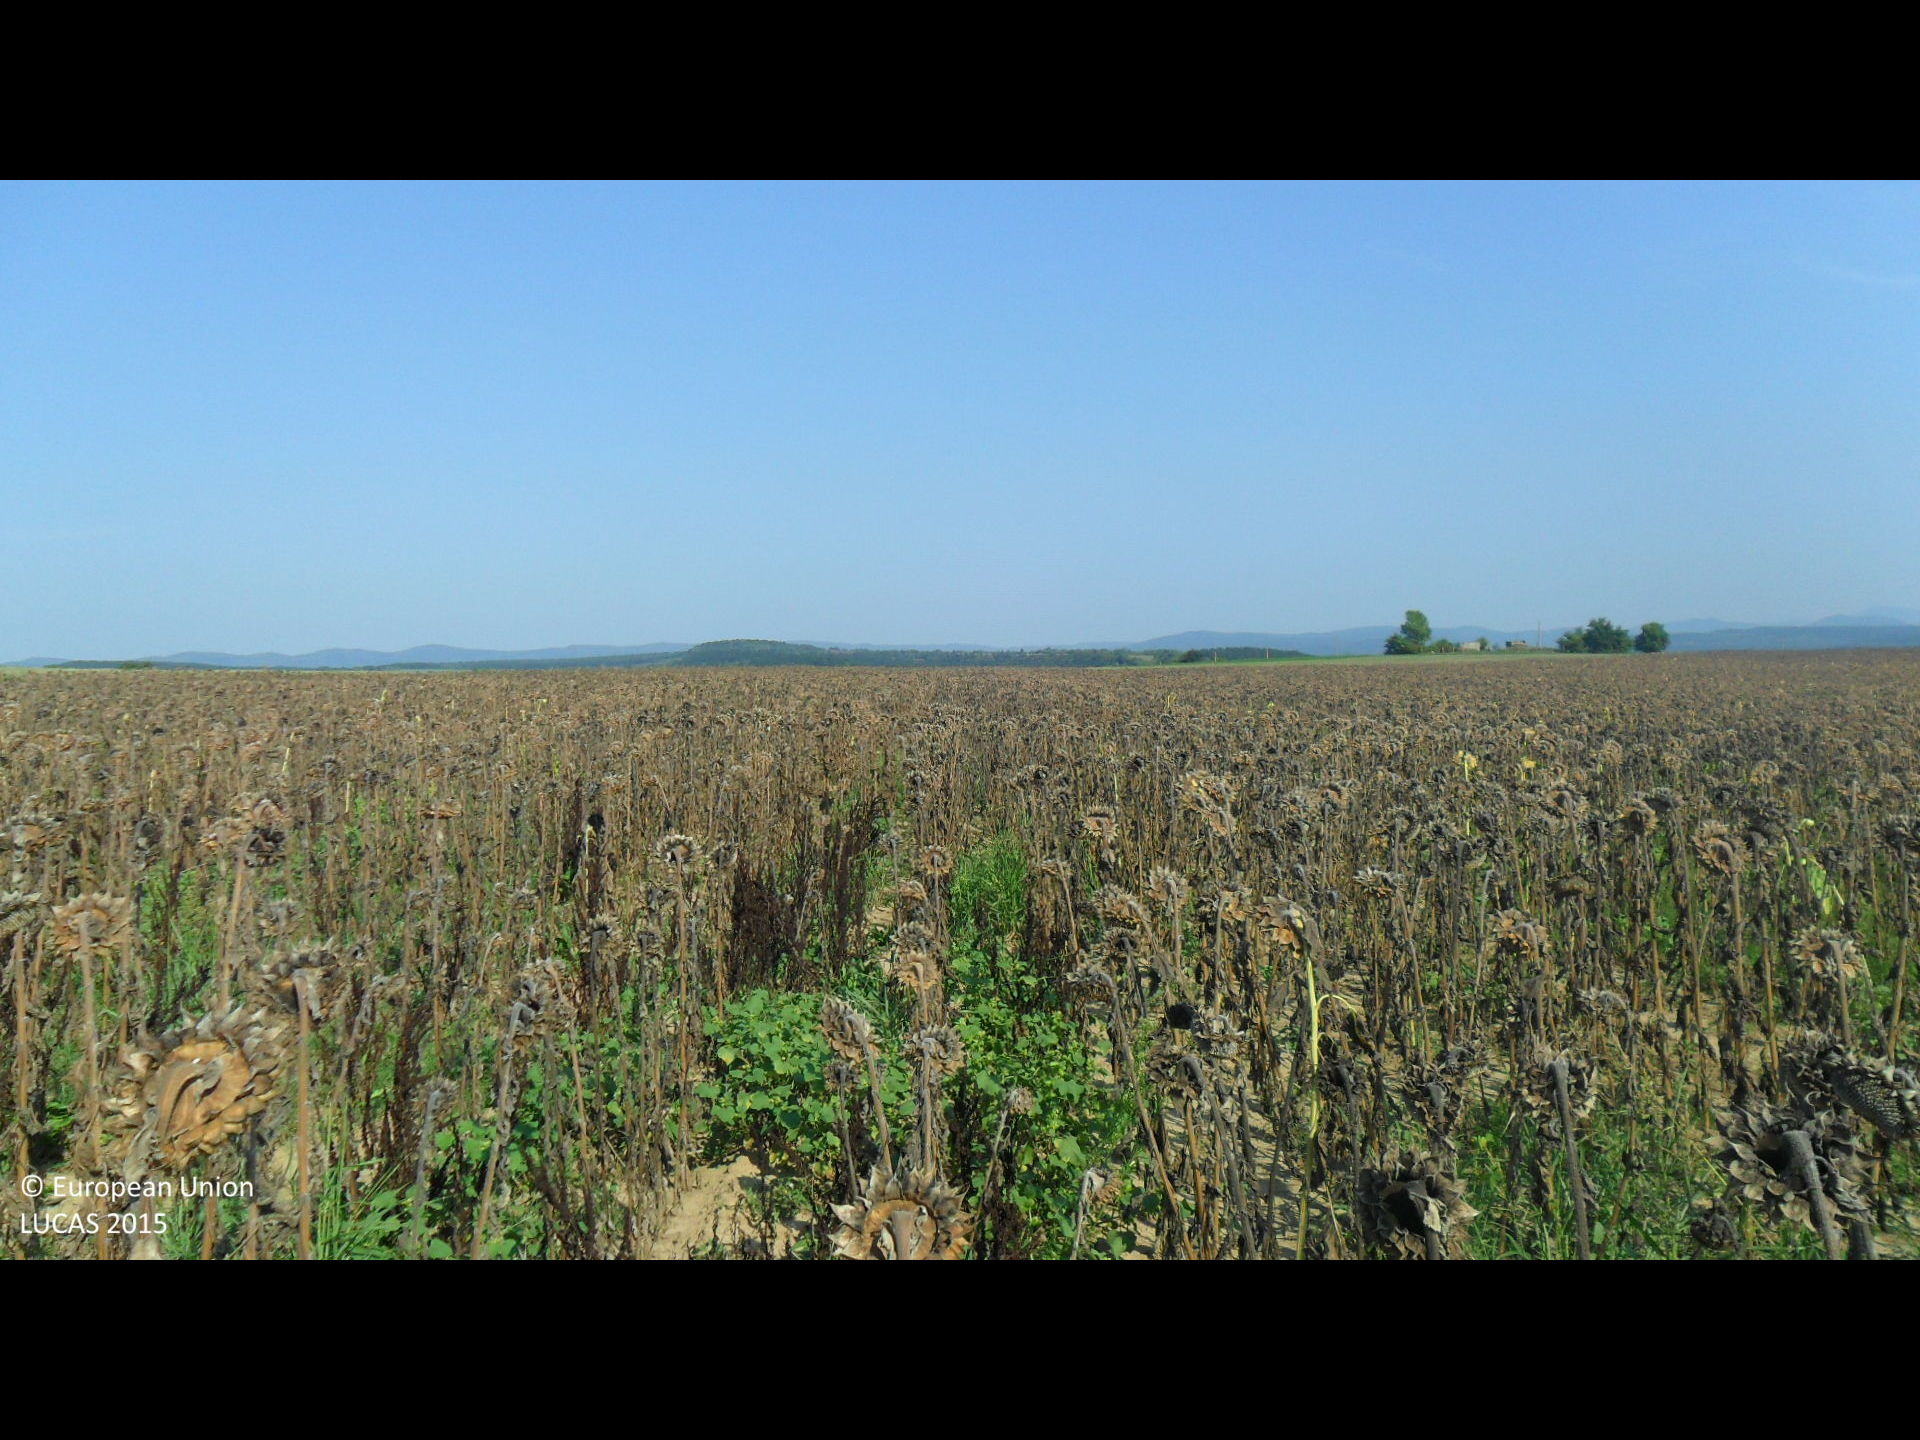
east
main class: Cropland
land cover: Sunflower
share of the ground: > 75 %
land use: Agriculture (excluding fallow land and kitchen gardens)
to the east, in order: Sunflower
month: September
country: BG
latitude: 43.0643
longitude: 26.6687
